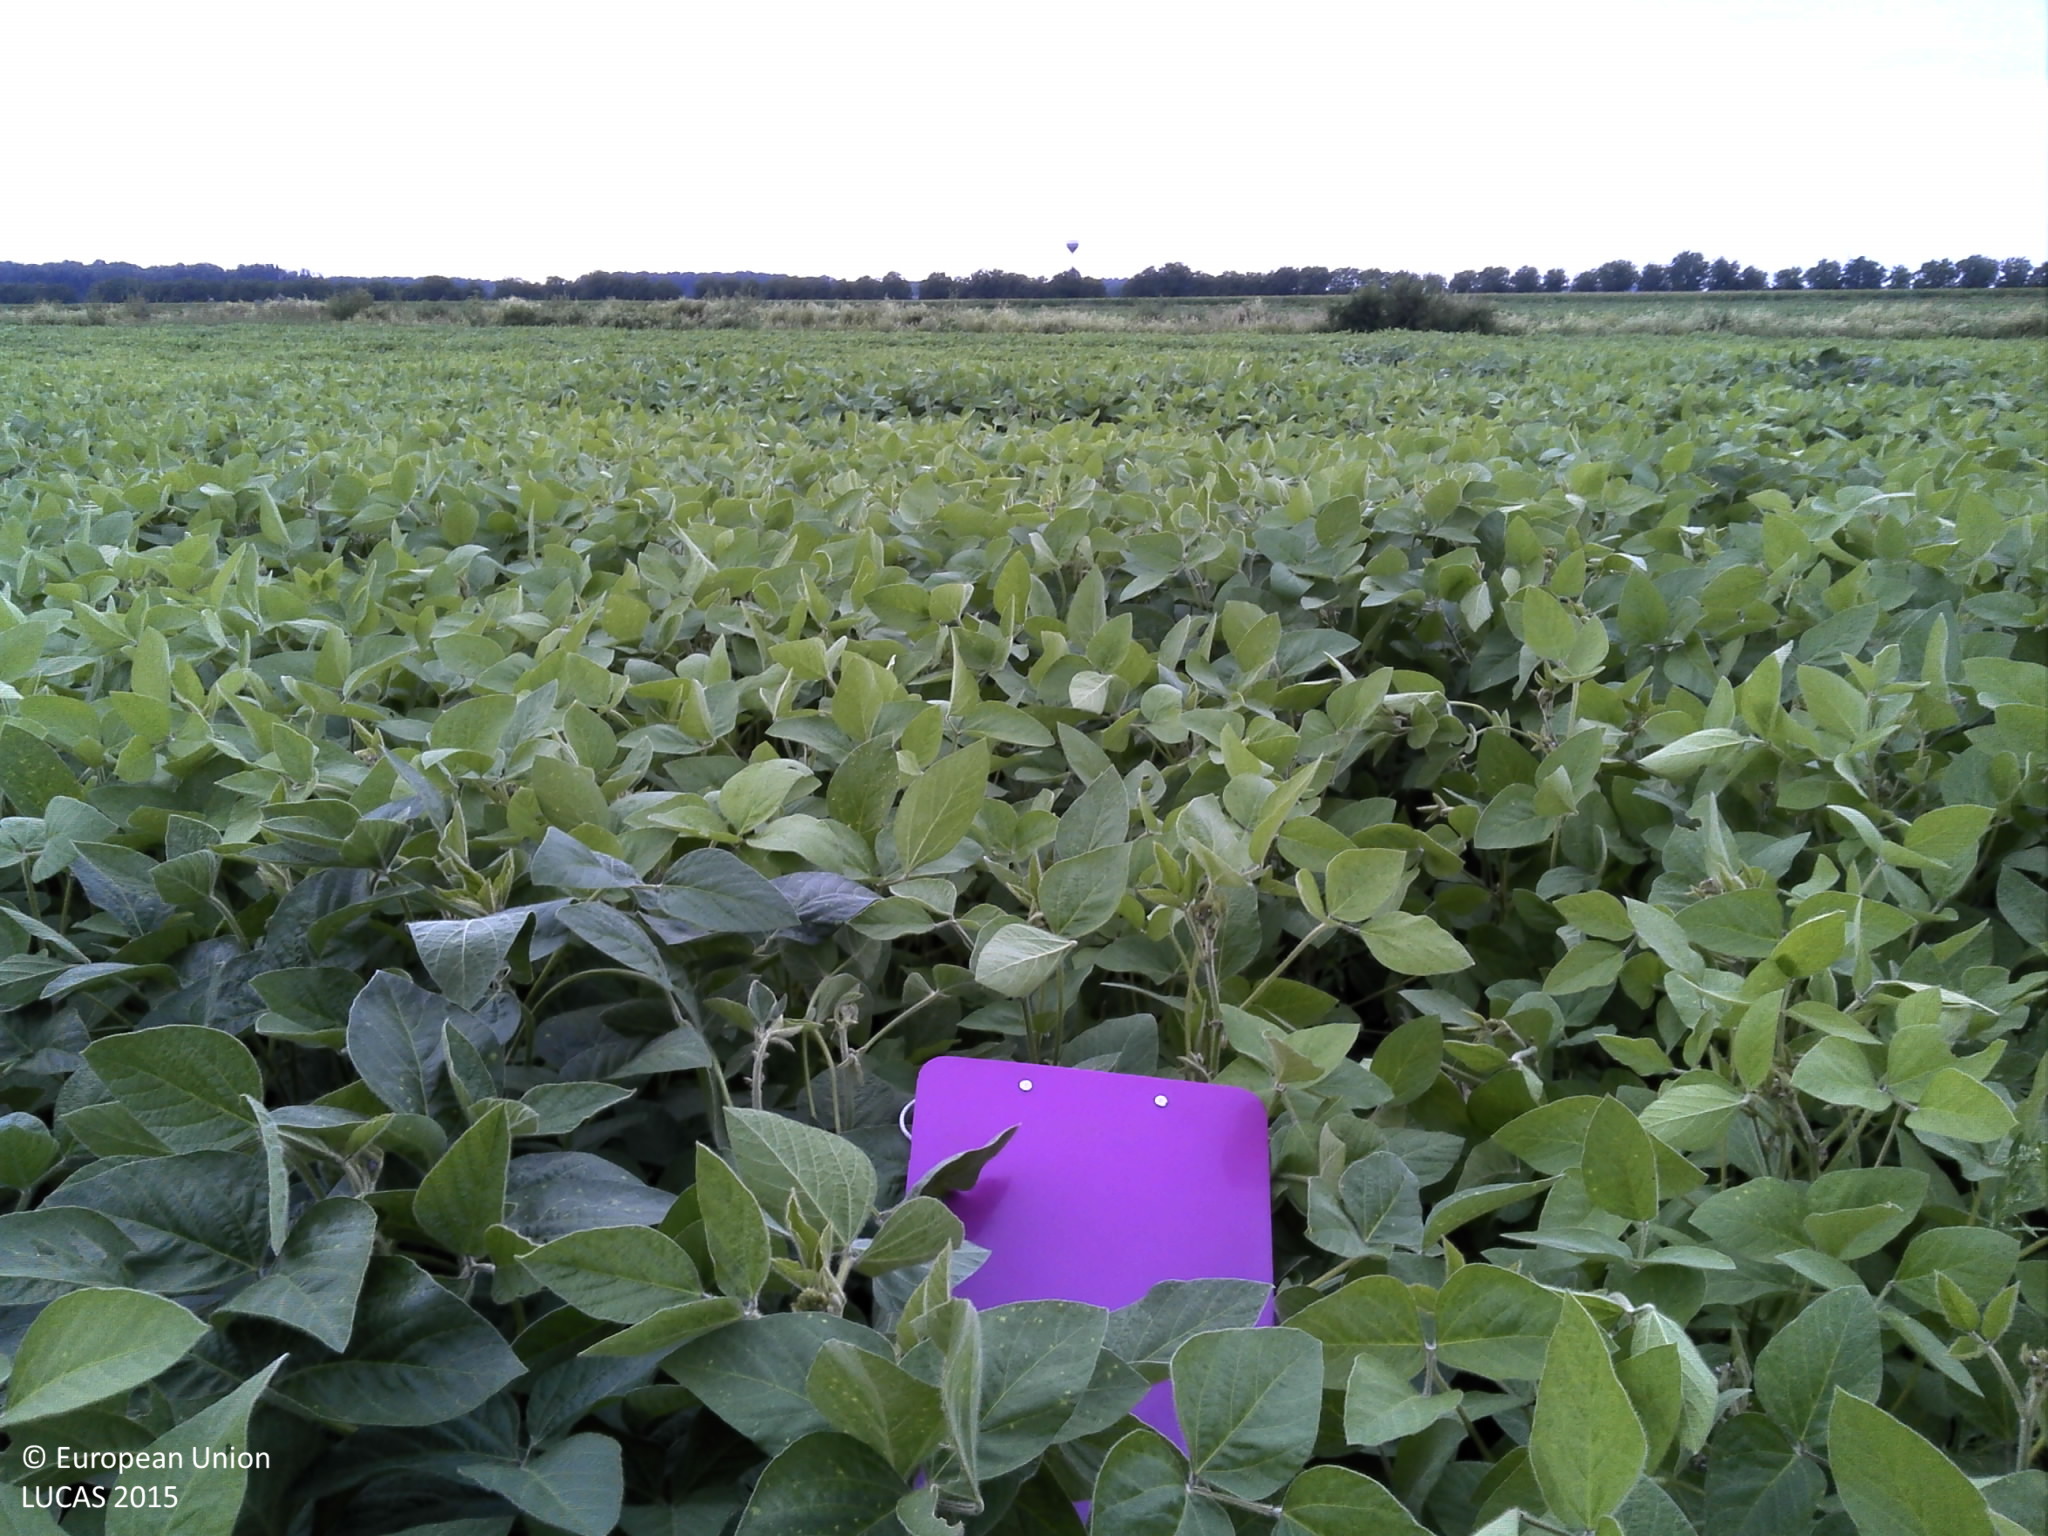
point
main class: Cropland
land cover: Soya
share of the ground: > 75 %
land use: Agriculture (excluding fallow land and kitchen gardens)
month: June
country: HR
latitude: 45.4860
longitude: 18.5147
